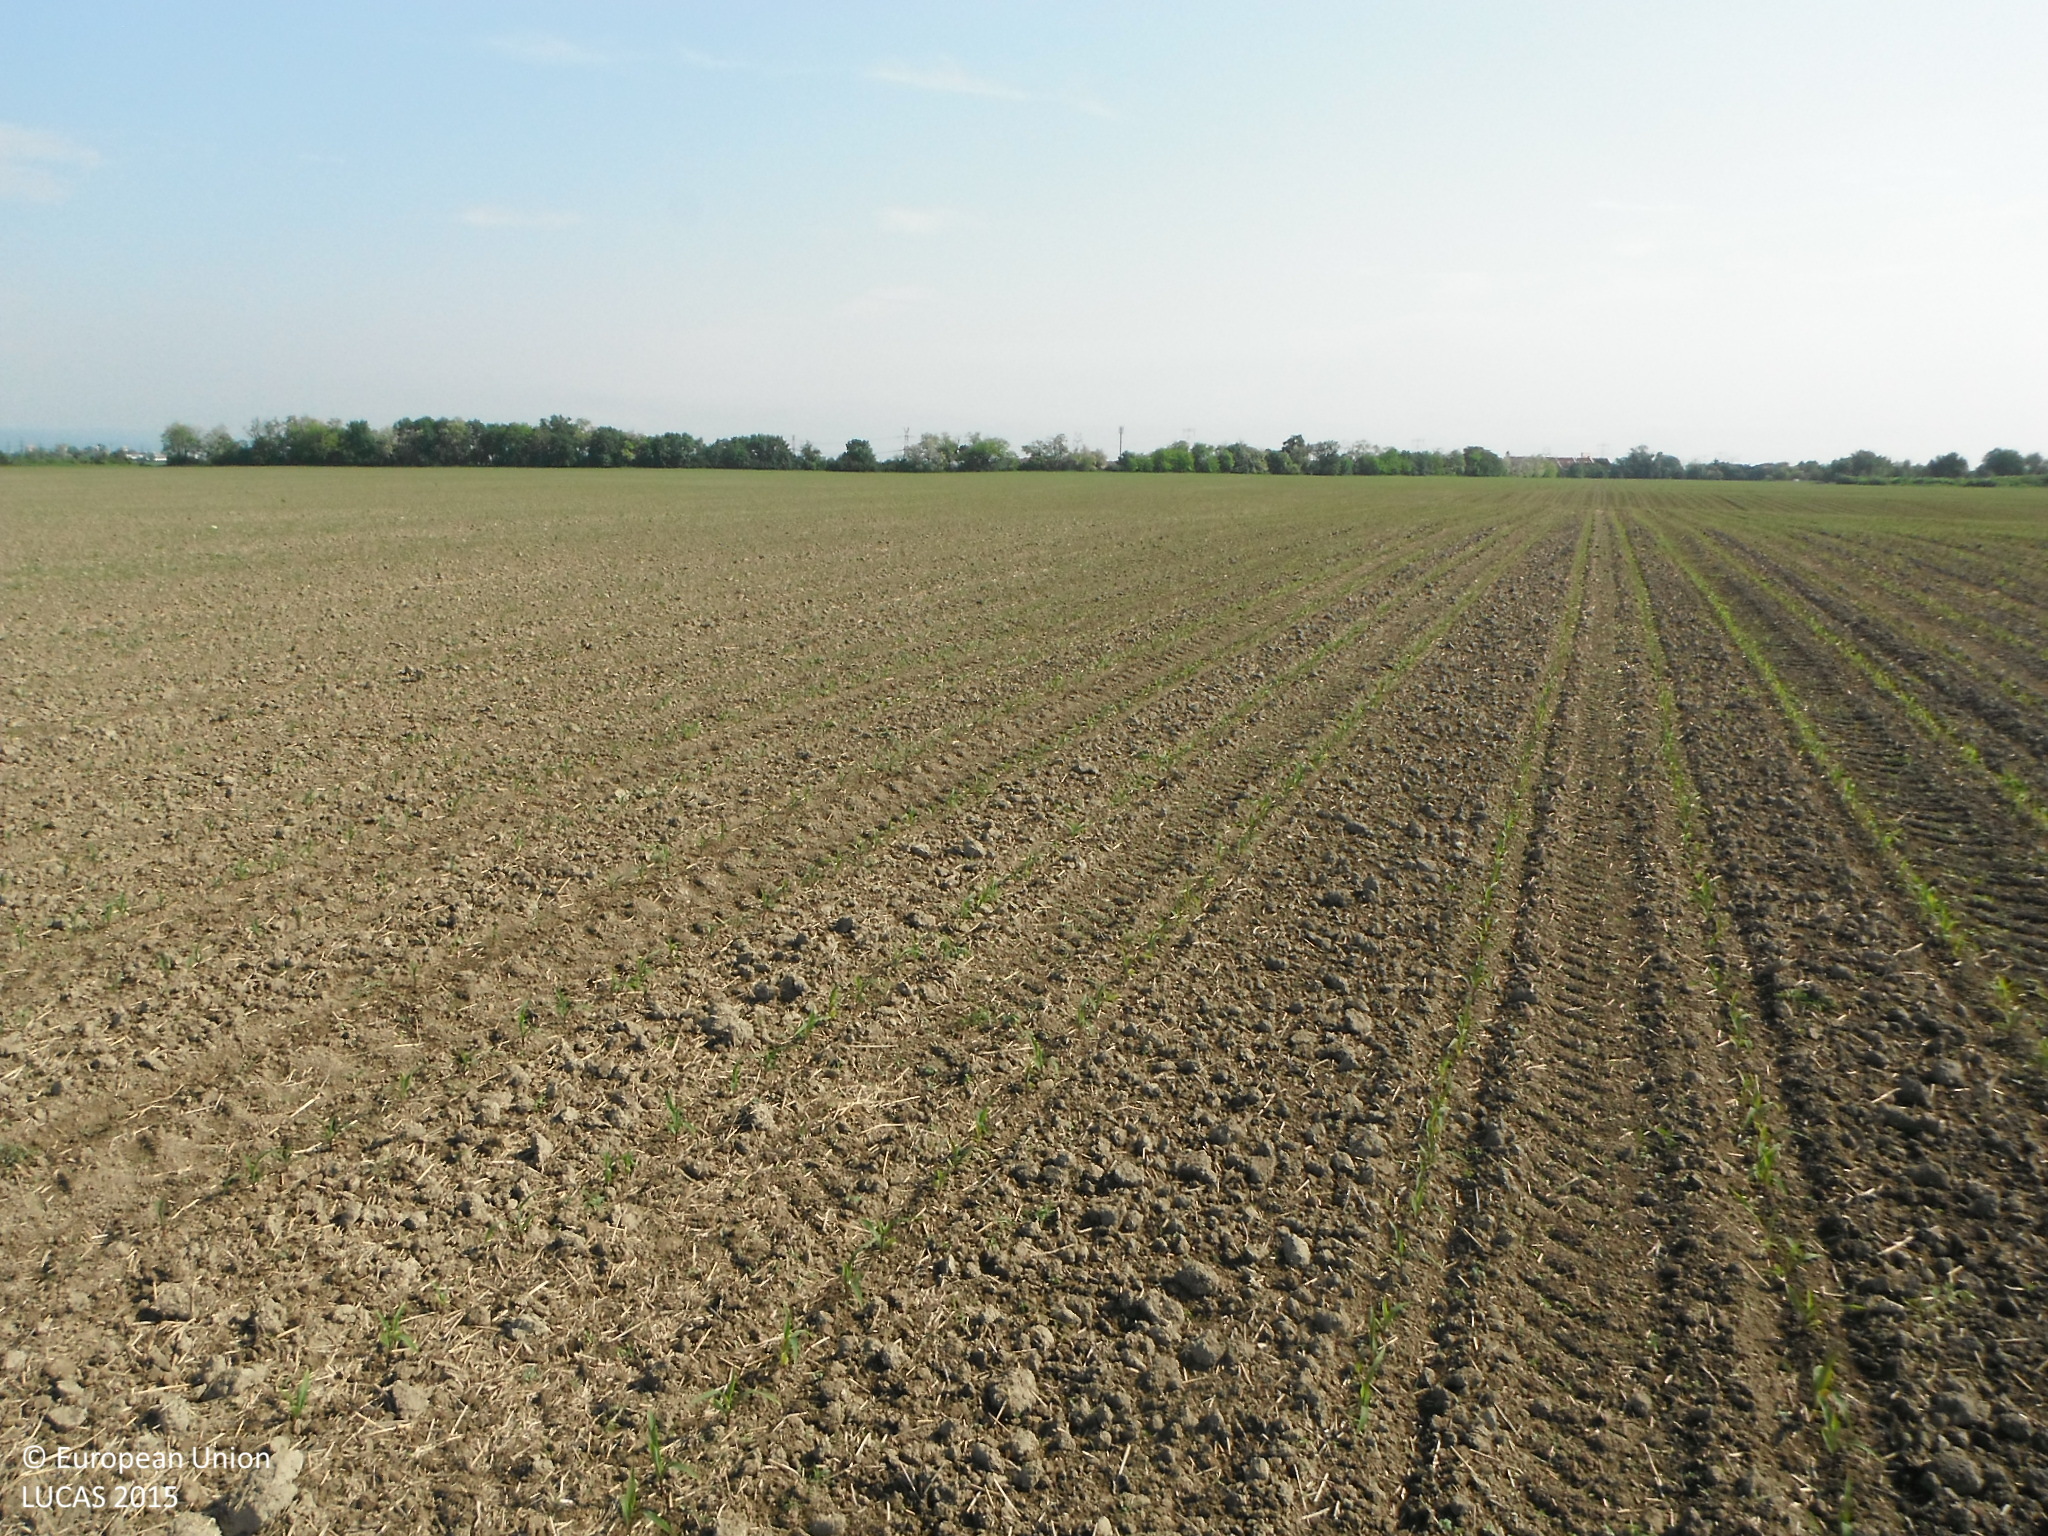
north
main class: Cropland
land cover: Maize
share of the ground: < 10 %
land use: Agriculture (excluding fallow land and kitchen gardens)
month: May
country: SK
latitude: 48.0951
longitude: 17.2187
